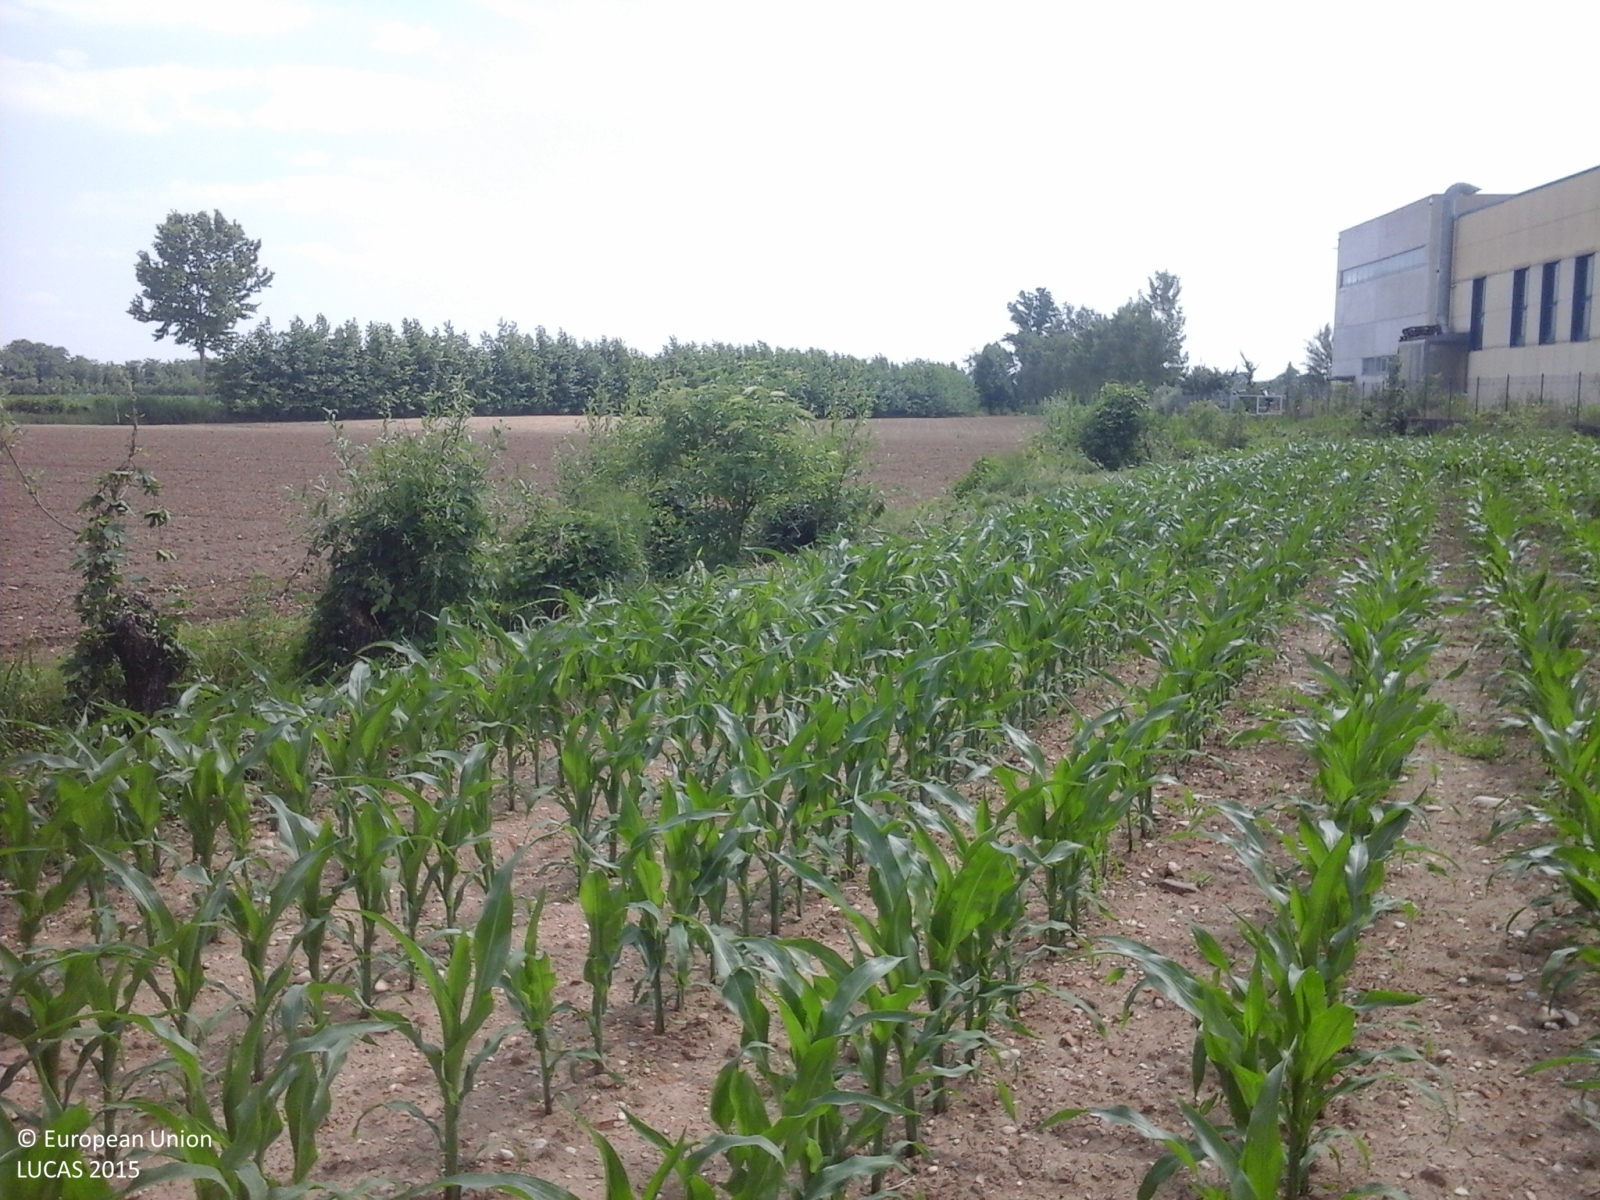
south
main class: Cropland
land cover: Maize
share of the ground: 25 - 50 %
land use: Agriculture (excluding fallow land and kitchen gardens)
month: May
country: IT
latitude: 45.6188
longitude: 11.5749
